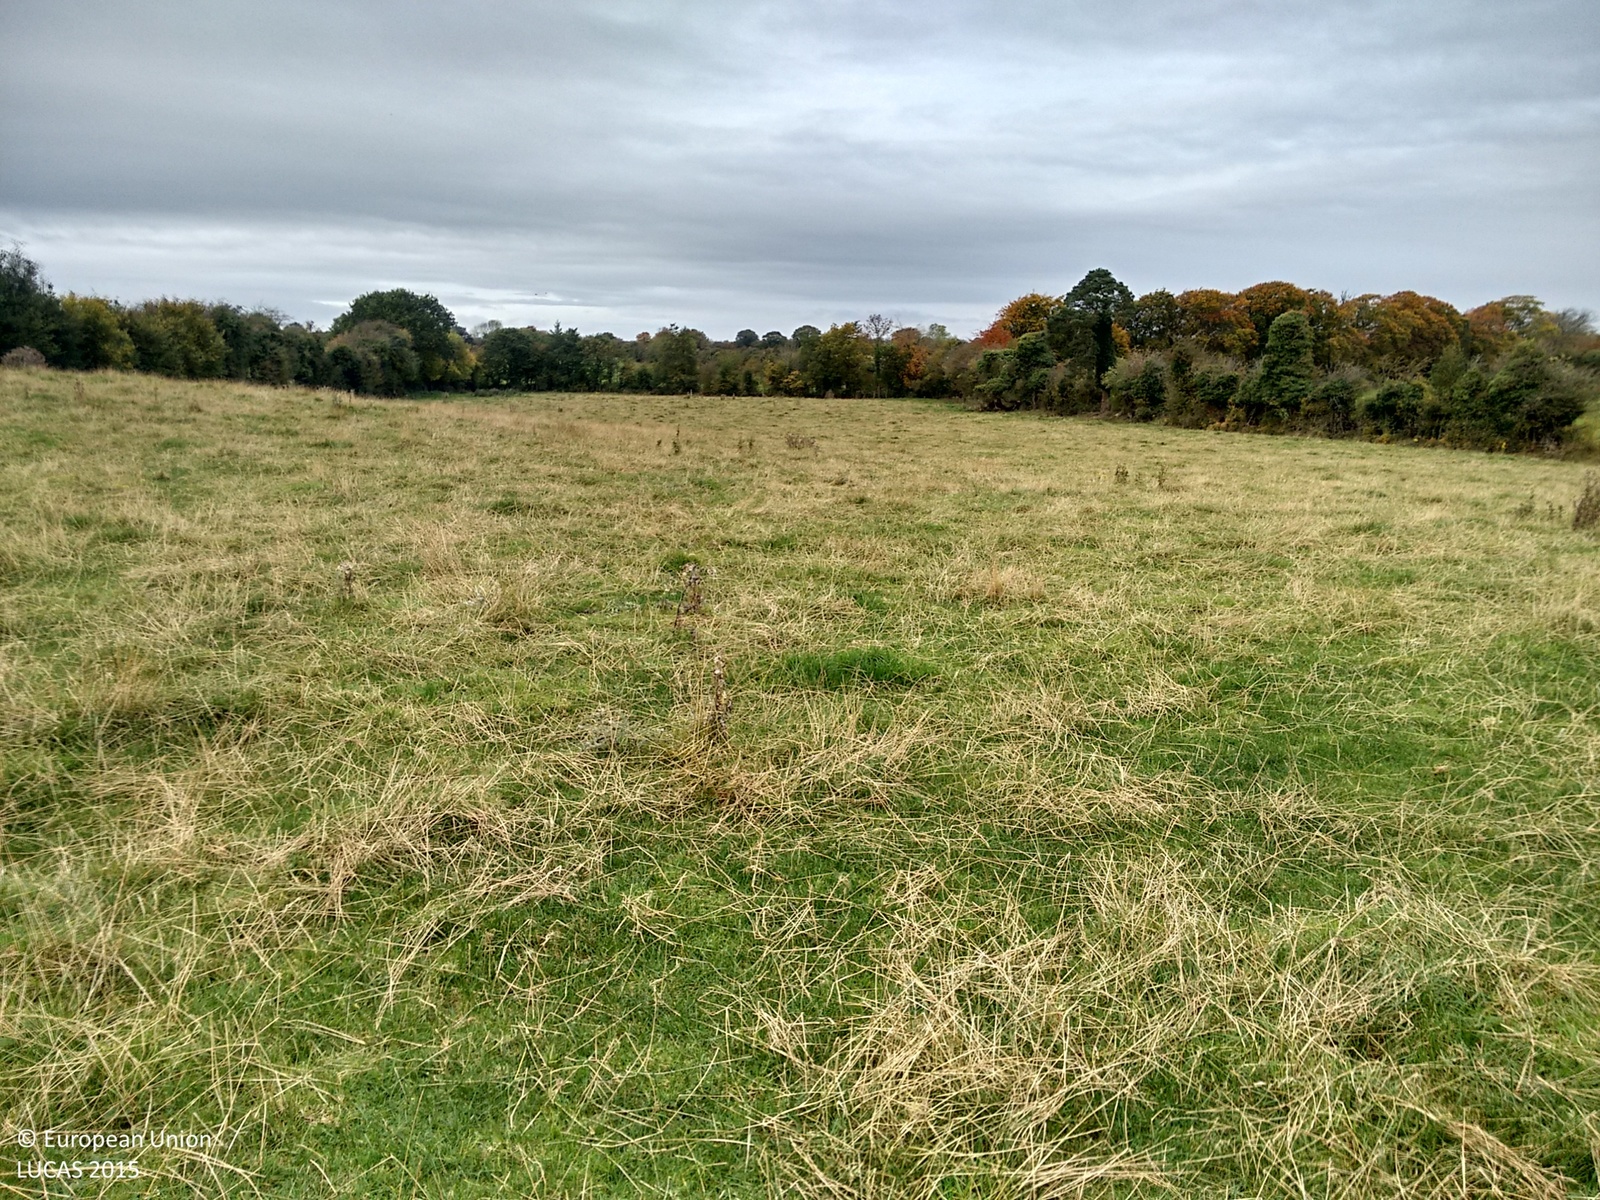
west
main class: Grassland
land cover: Grassland without tree/shrub cover
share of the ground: > 75 %
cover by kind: herbaceous plants 100 %
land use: Agriculture (excluding fallow land and kitchen gardens)
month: October
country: IE
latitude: 53.0815
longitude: -7.7995
